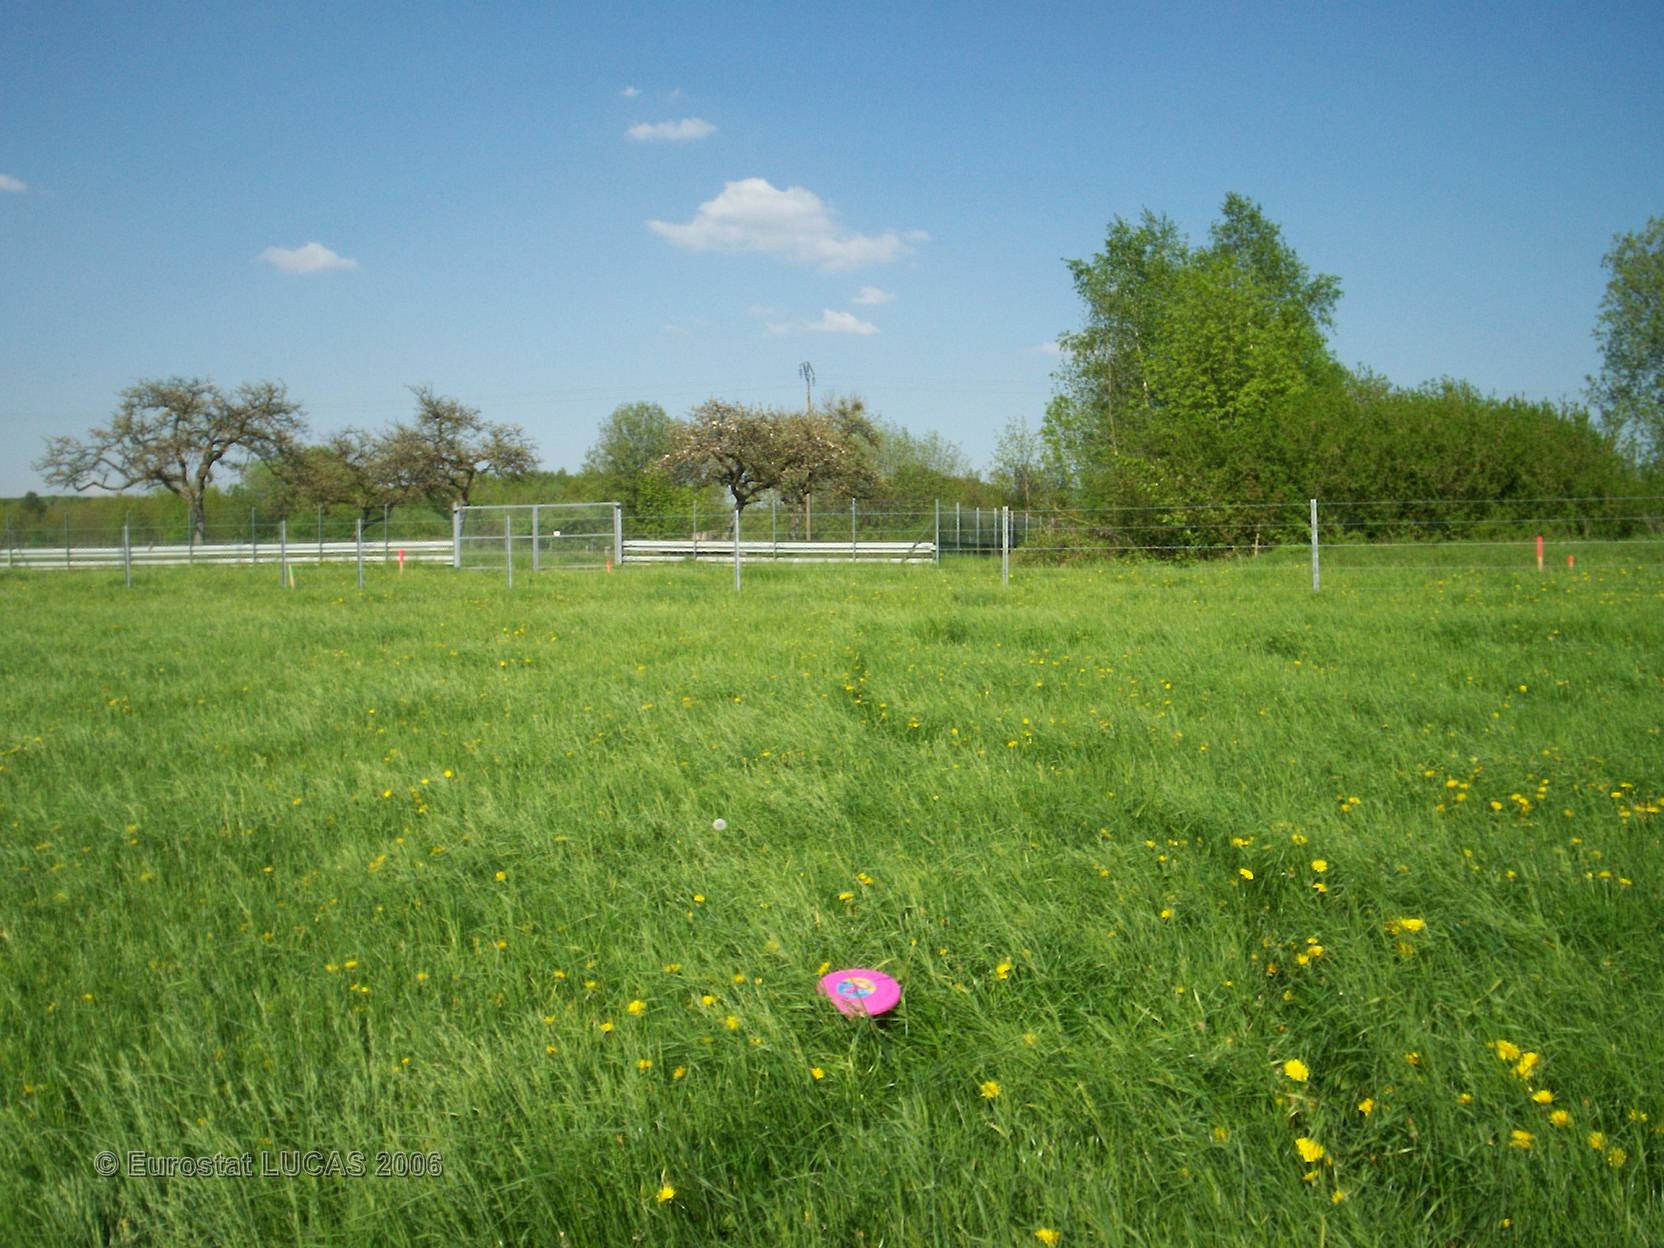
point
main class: Grassland
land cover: Grassland without tree/shrub cover
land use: Agriculture (excluding fallow land and kitchen gardens)
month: May
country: FR
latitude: 49.7330
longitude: 5.0166
